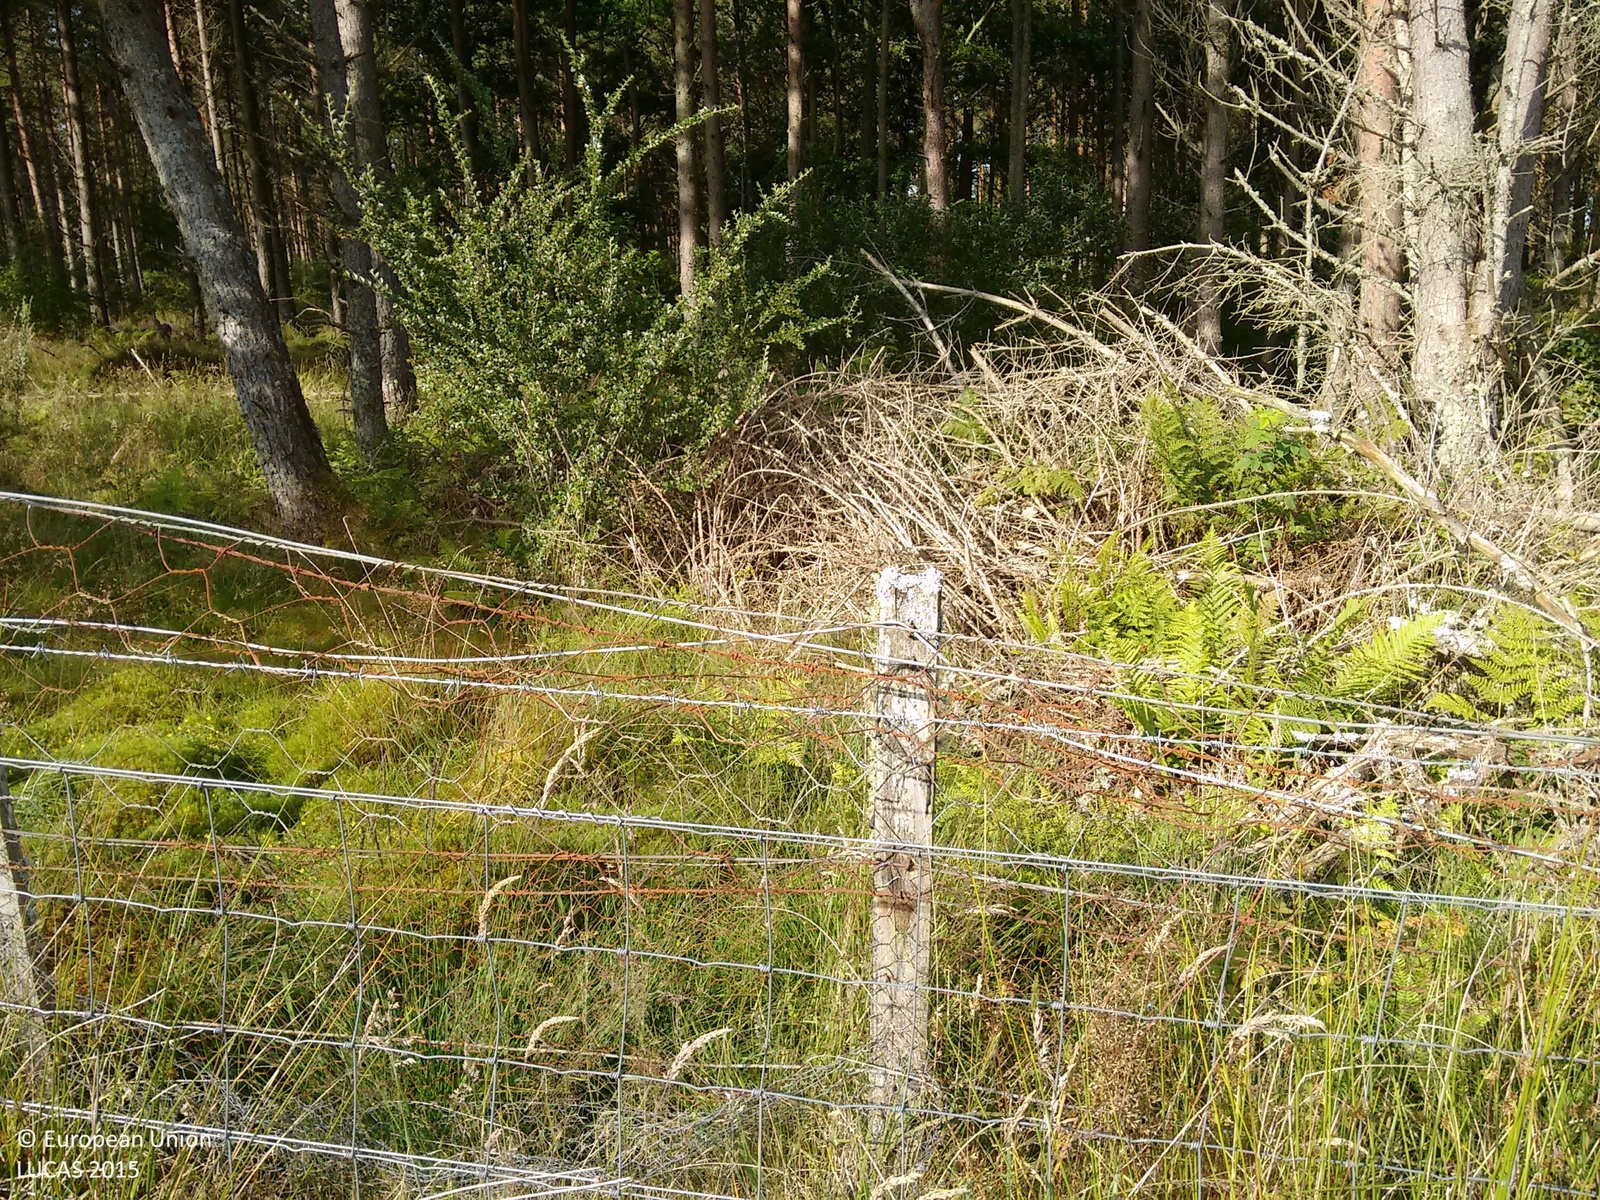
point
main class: Woodland
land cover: Pine dominated coniferous woodland
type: exotic forest
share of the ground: > 75 %
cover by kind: coniferous forest trees 60 %, herbaceous plants 40 %
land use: Forestry
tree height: > 5 m
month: August
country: GB
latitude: 57.9168
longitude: -4.0386
